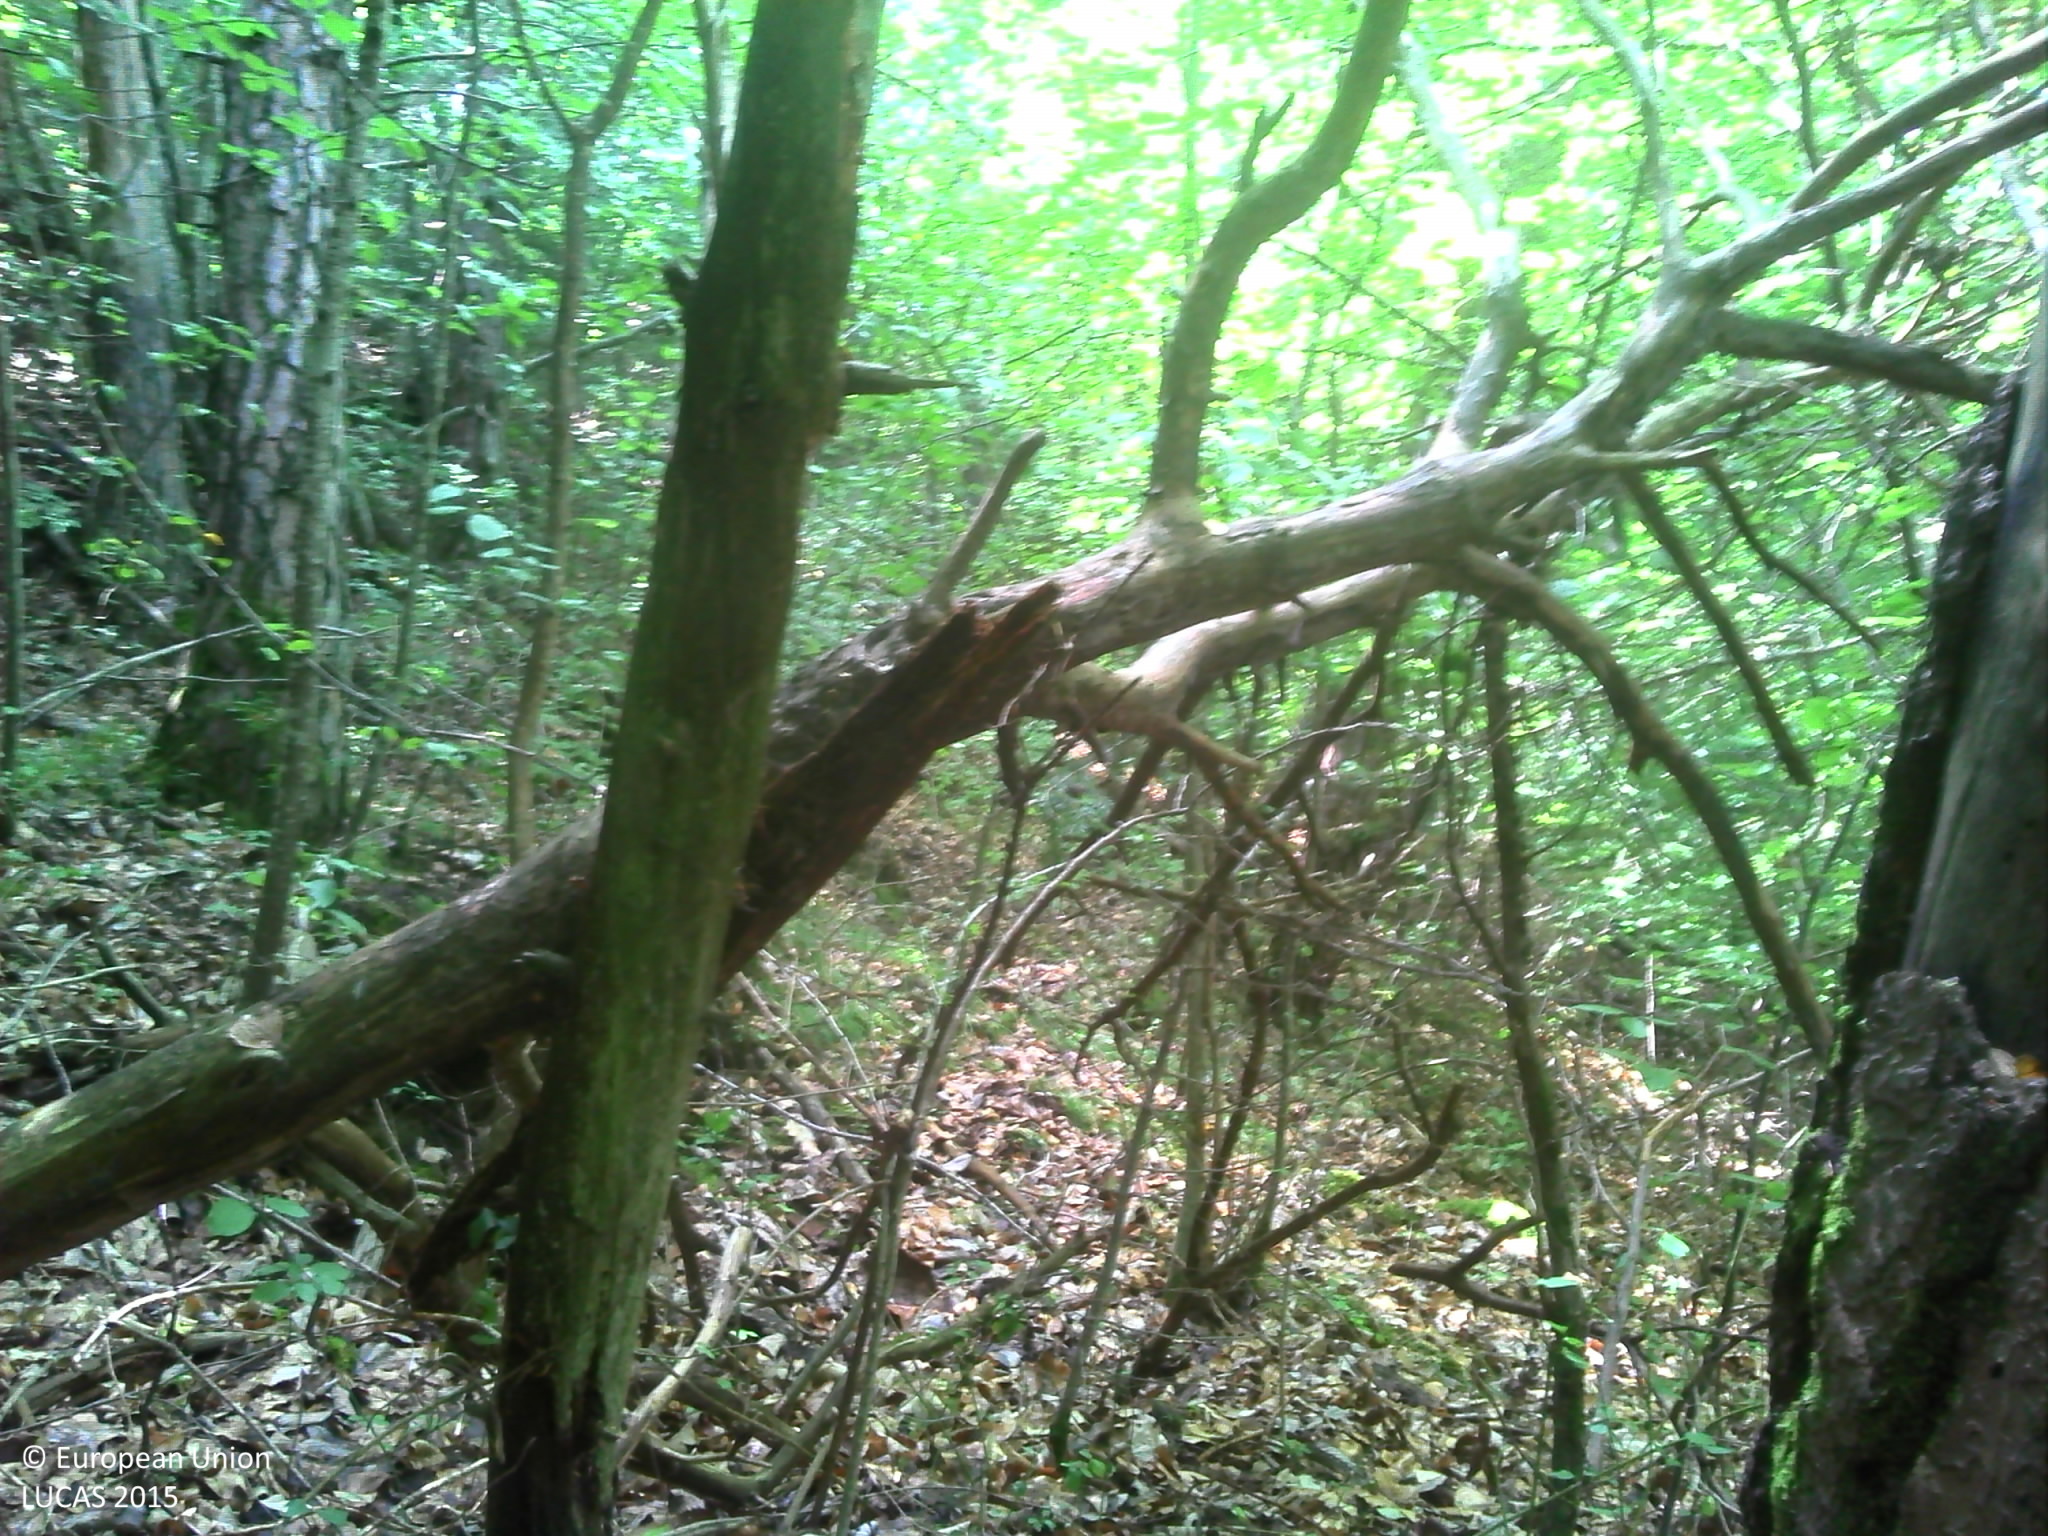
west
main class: Woodland
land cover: Spruce dominated mixed woodland
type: coniferous forest of the mediterranean region
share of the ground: > 75 %
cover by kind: coniferous forest trees 50 %, broadleaved forest trees 35 %, shrubs 10 %, herbaceous plants 5 %
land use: Forestry
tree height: > 5 m
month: July
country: FR
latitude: 44.5029
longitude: 6.3465
